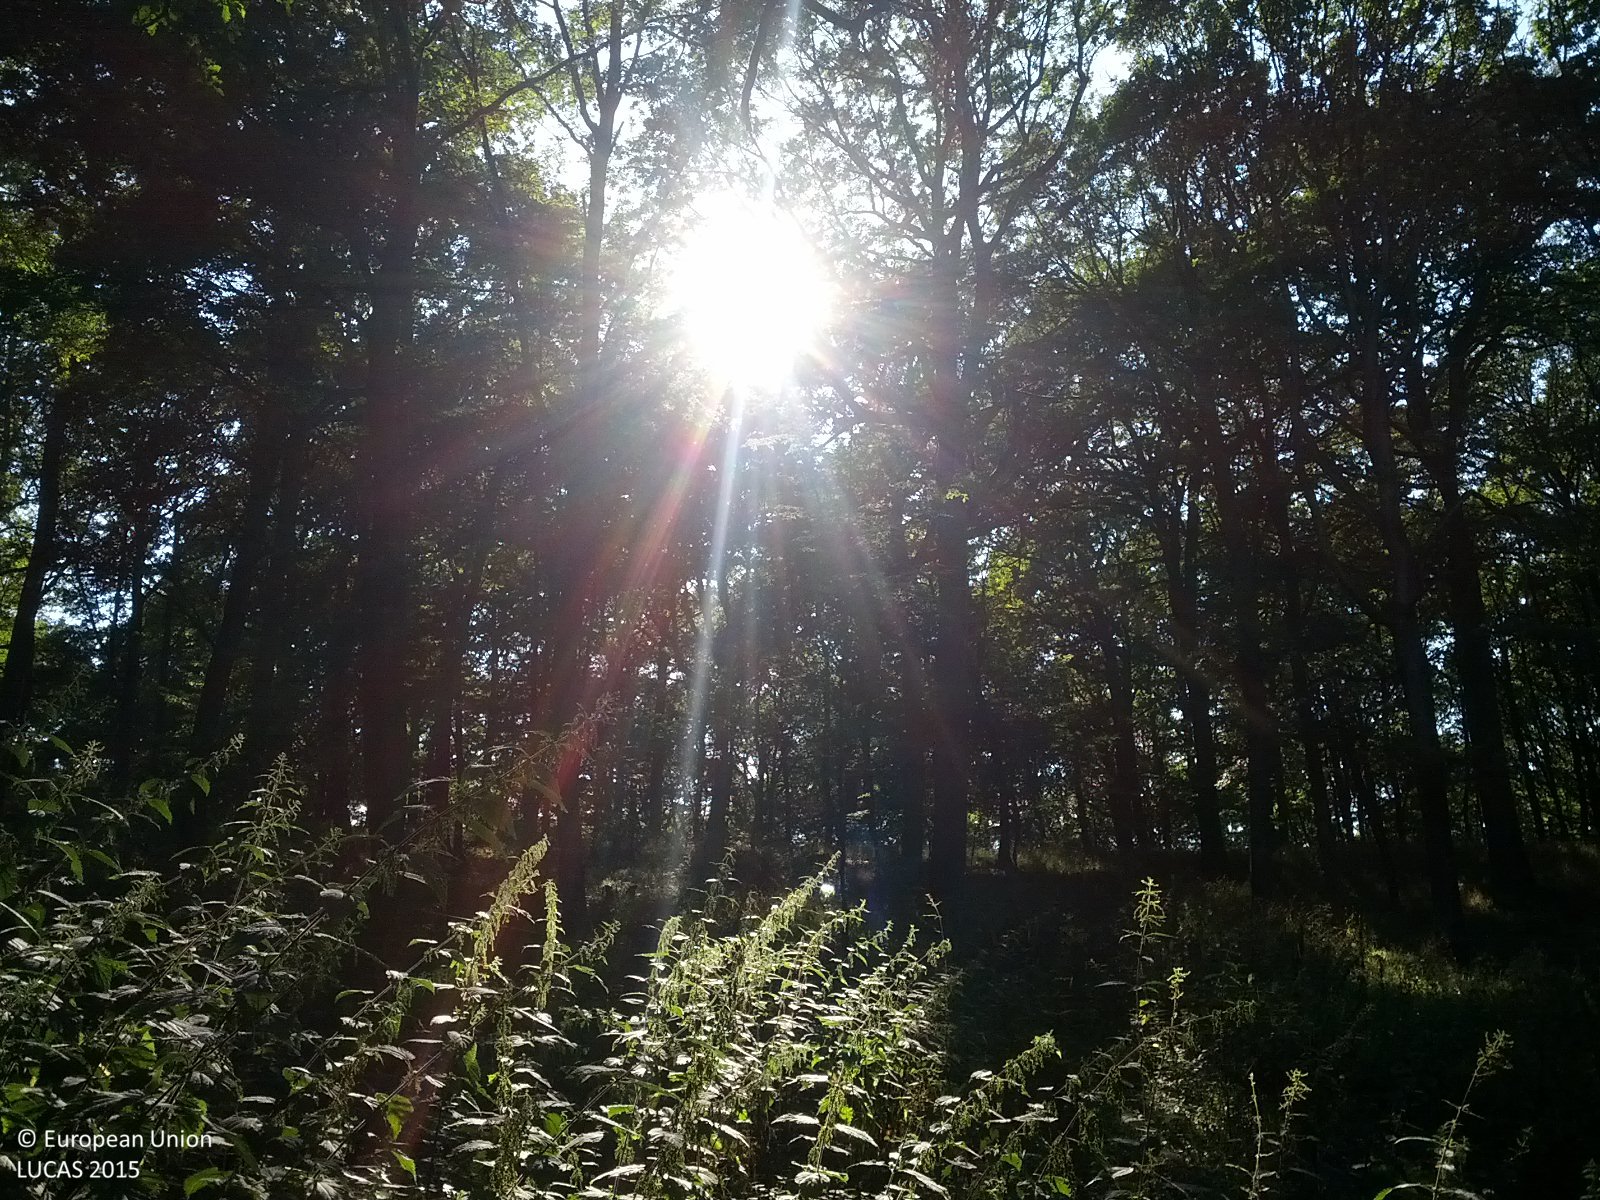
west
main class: Woodland
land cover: Broadleaved woodland
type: acidophilous oak and oak-birch forest
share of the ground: > 75 %
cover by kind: broadleaved forest trees 80 %, herbaceous plants 20 %
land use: Forestry
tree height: > 5 m
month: July
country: AT
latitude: 48.5499
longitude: 16.2775
